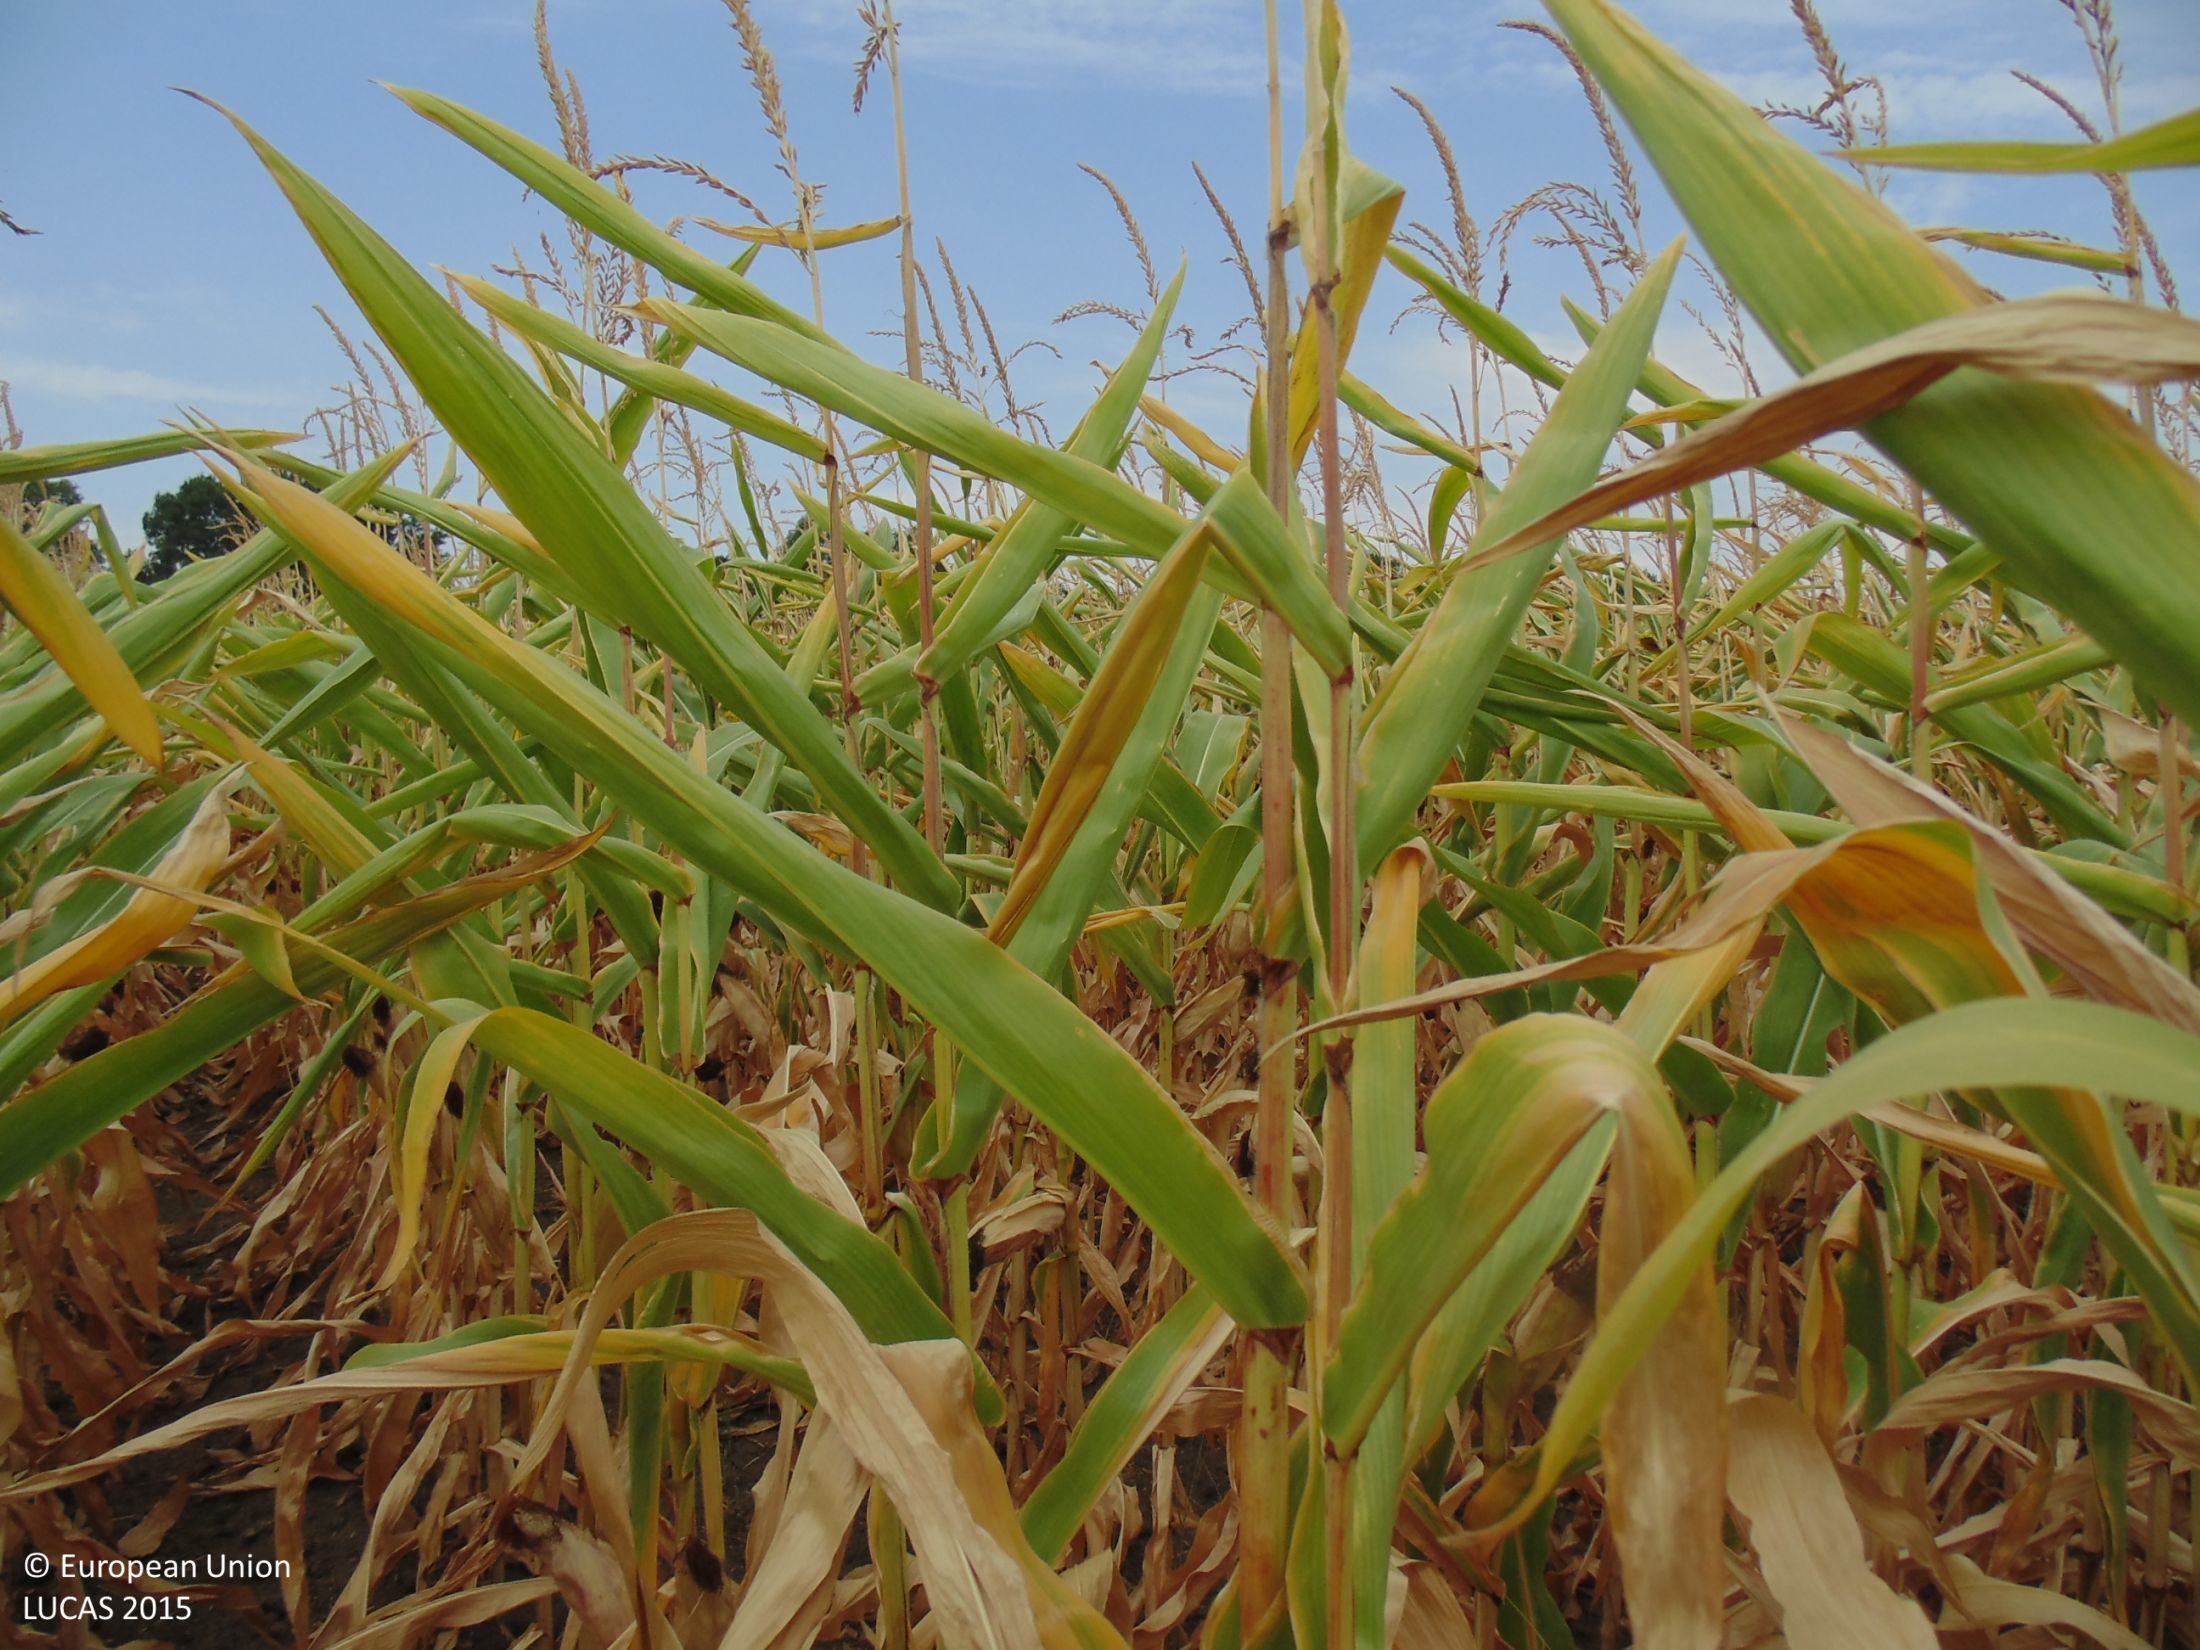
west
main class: Cropland
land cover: Maize
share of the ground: > 75 %
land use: Agriculture (excluding fallow land and kitchen gardens)
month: August
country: BG
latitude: 43.9439
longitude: 27.7741
